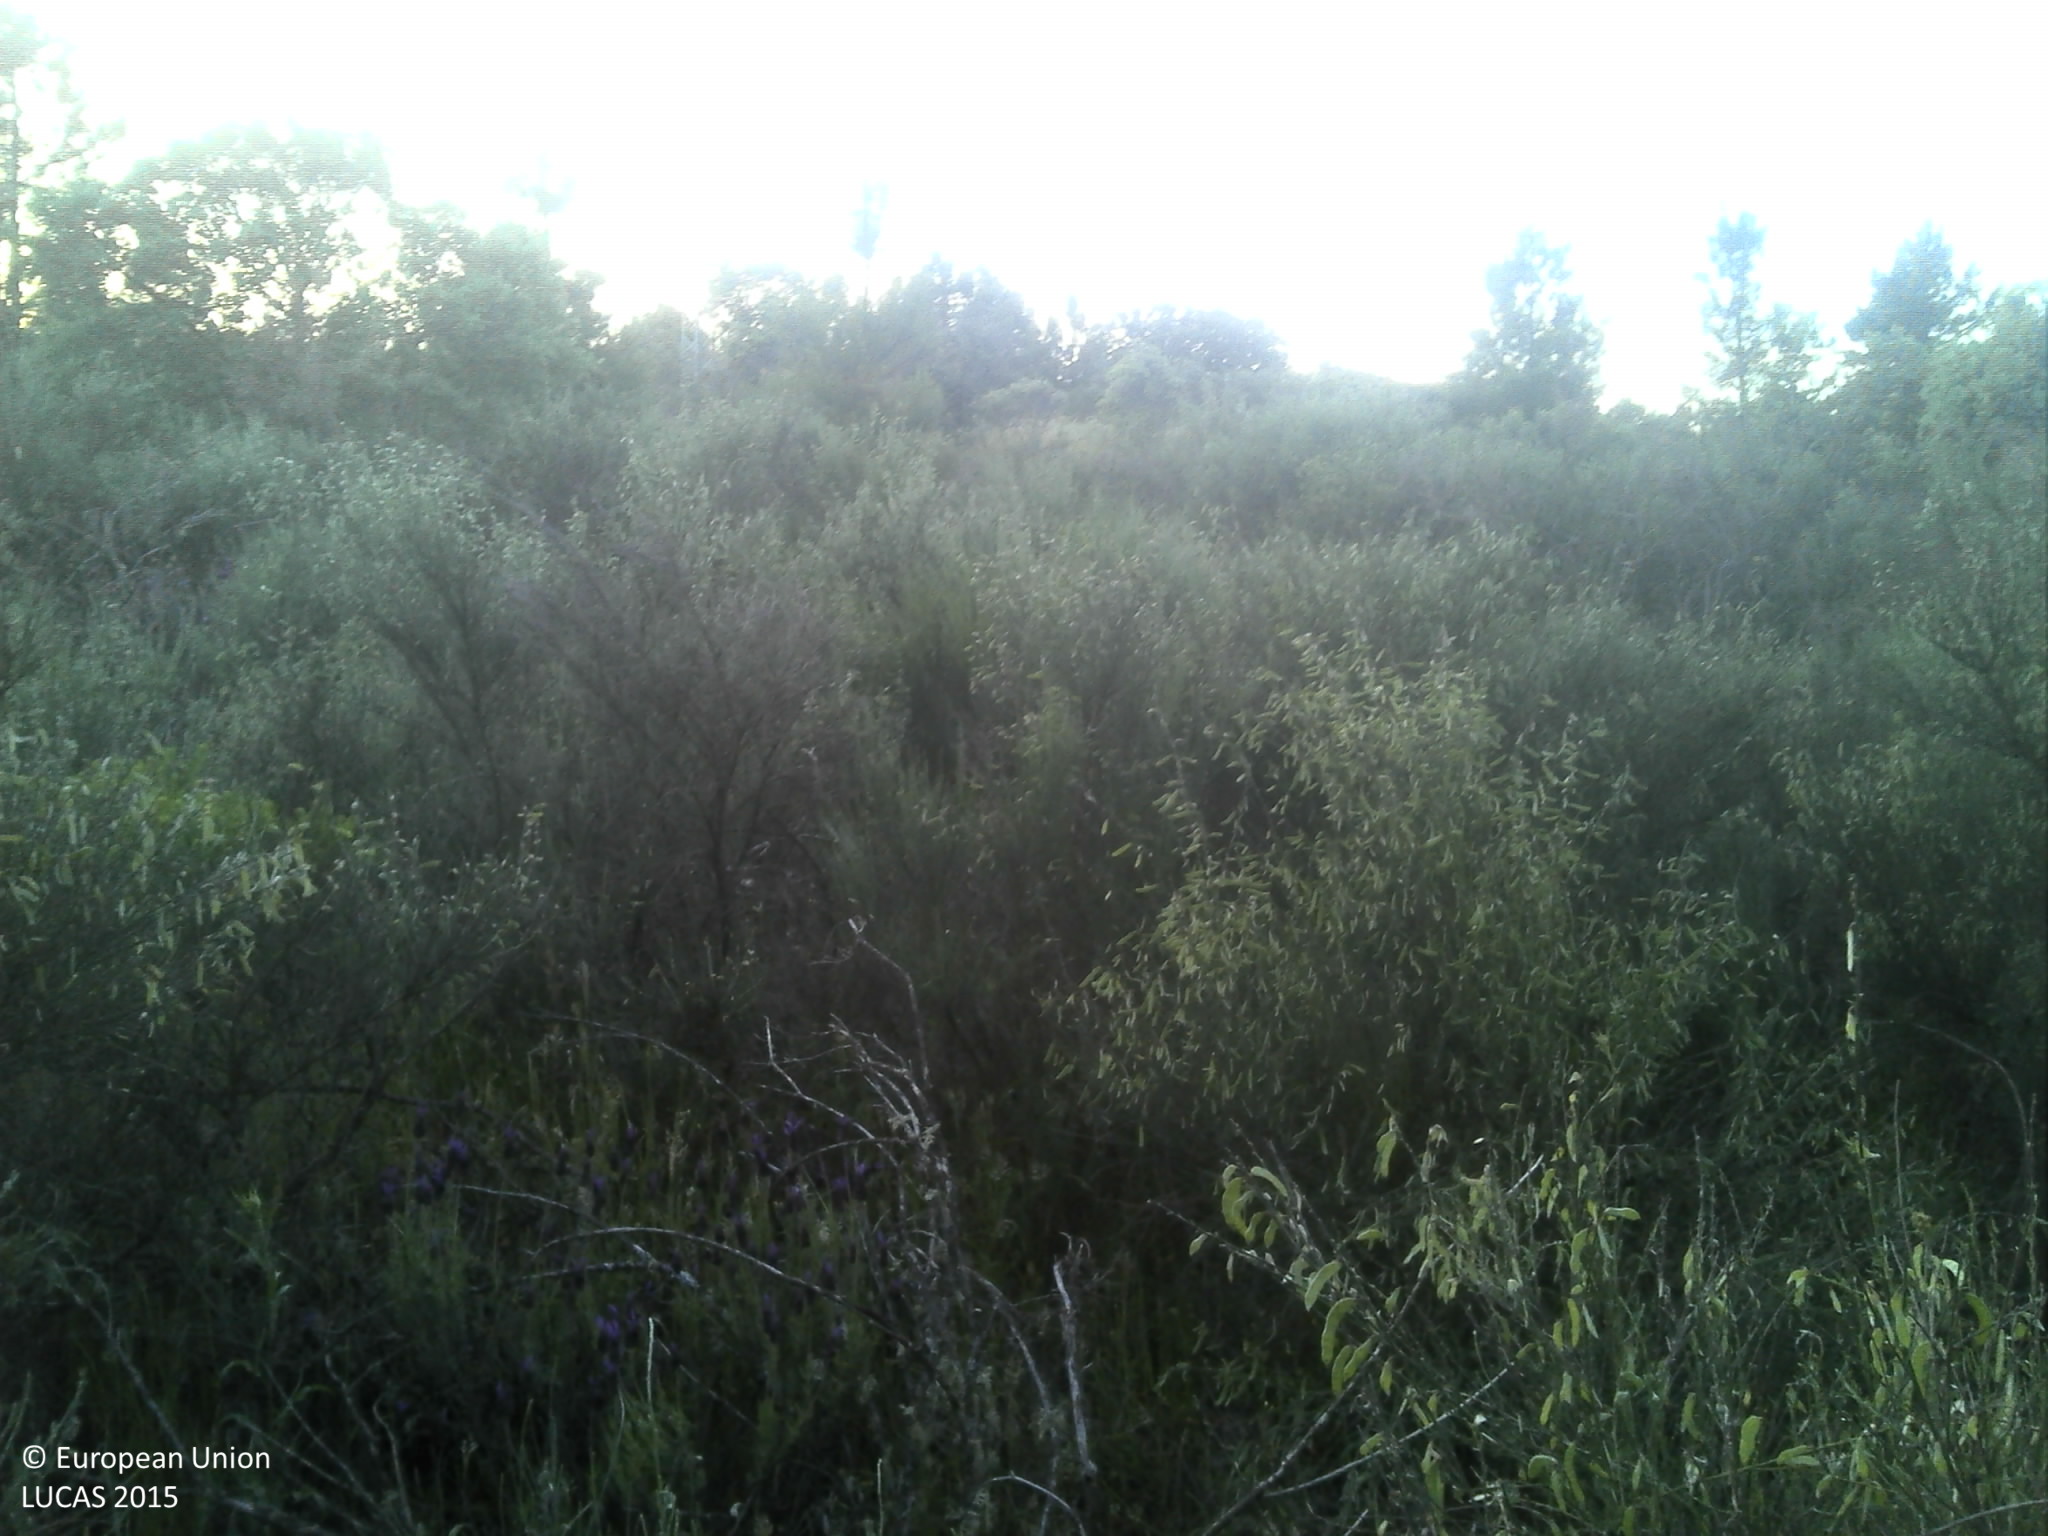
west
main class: Shrubland
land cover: Shrubland with sparse tree cover
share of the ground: > 75 %
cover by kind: shrubs 95 %, broadleaved forest trees 5 %
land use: Abandoned areas
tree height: > 5 m
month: May
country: PT
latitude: 40.6648
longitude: -7.3444
